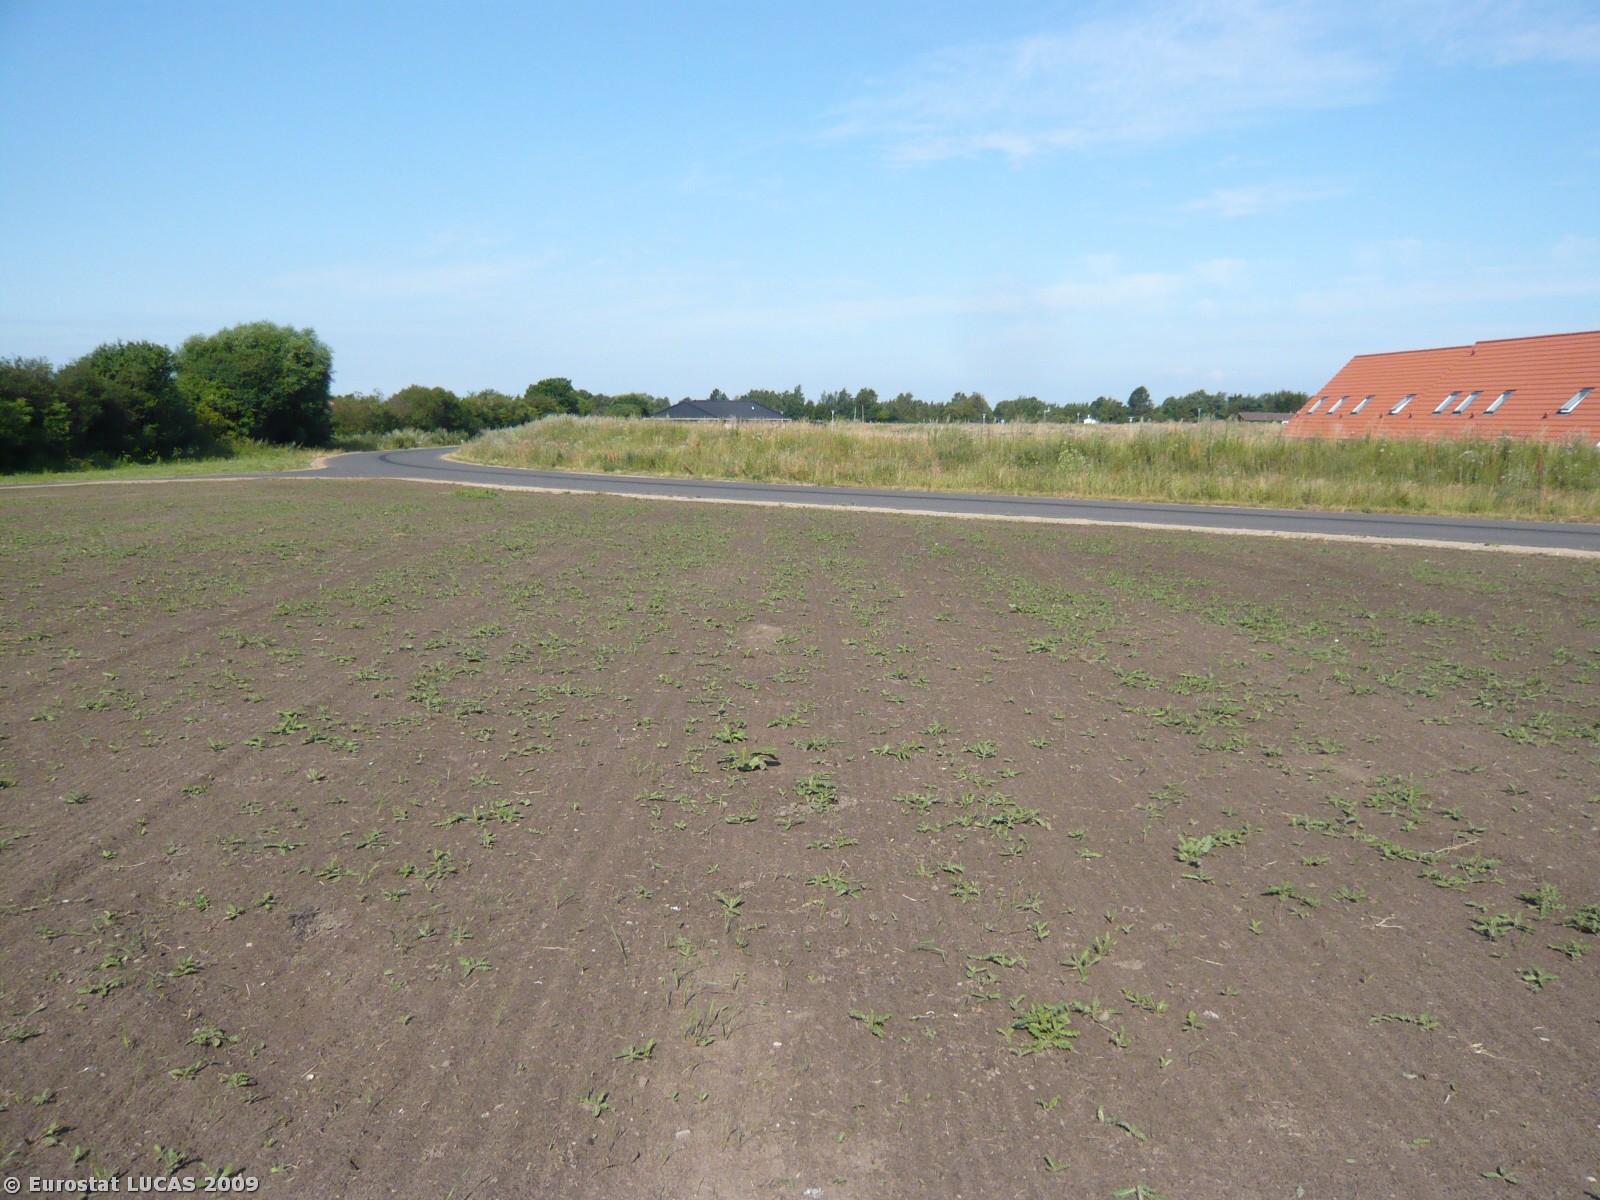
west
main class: Grassland
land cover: Spontaneously vegetated surfaces
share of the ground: 10 - 25 %
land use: Residential
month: July
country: DK
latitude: 55.7495
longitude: 11.3210
